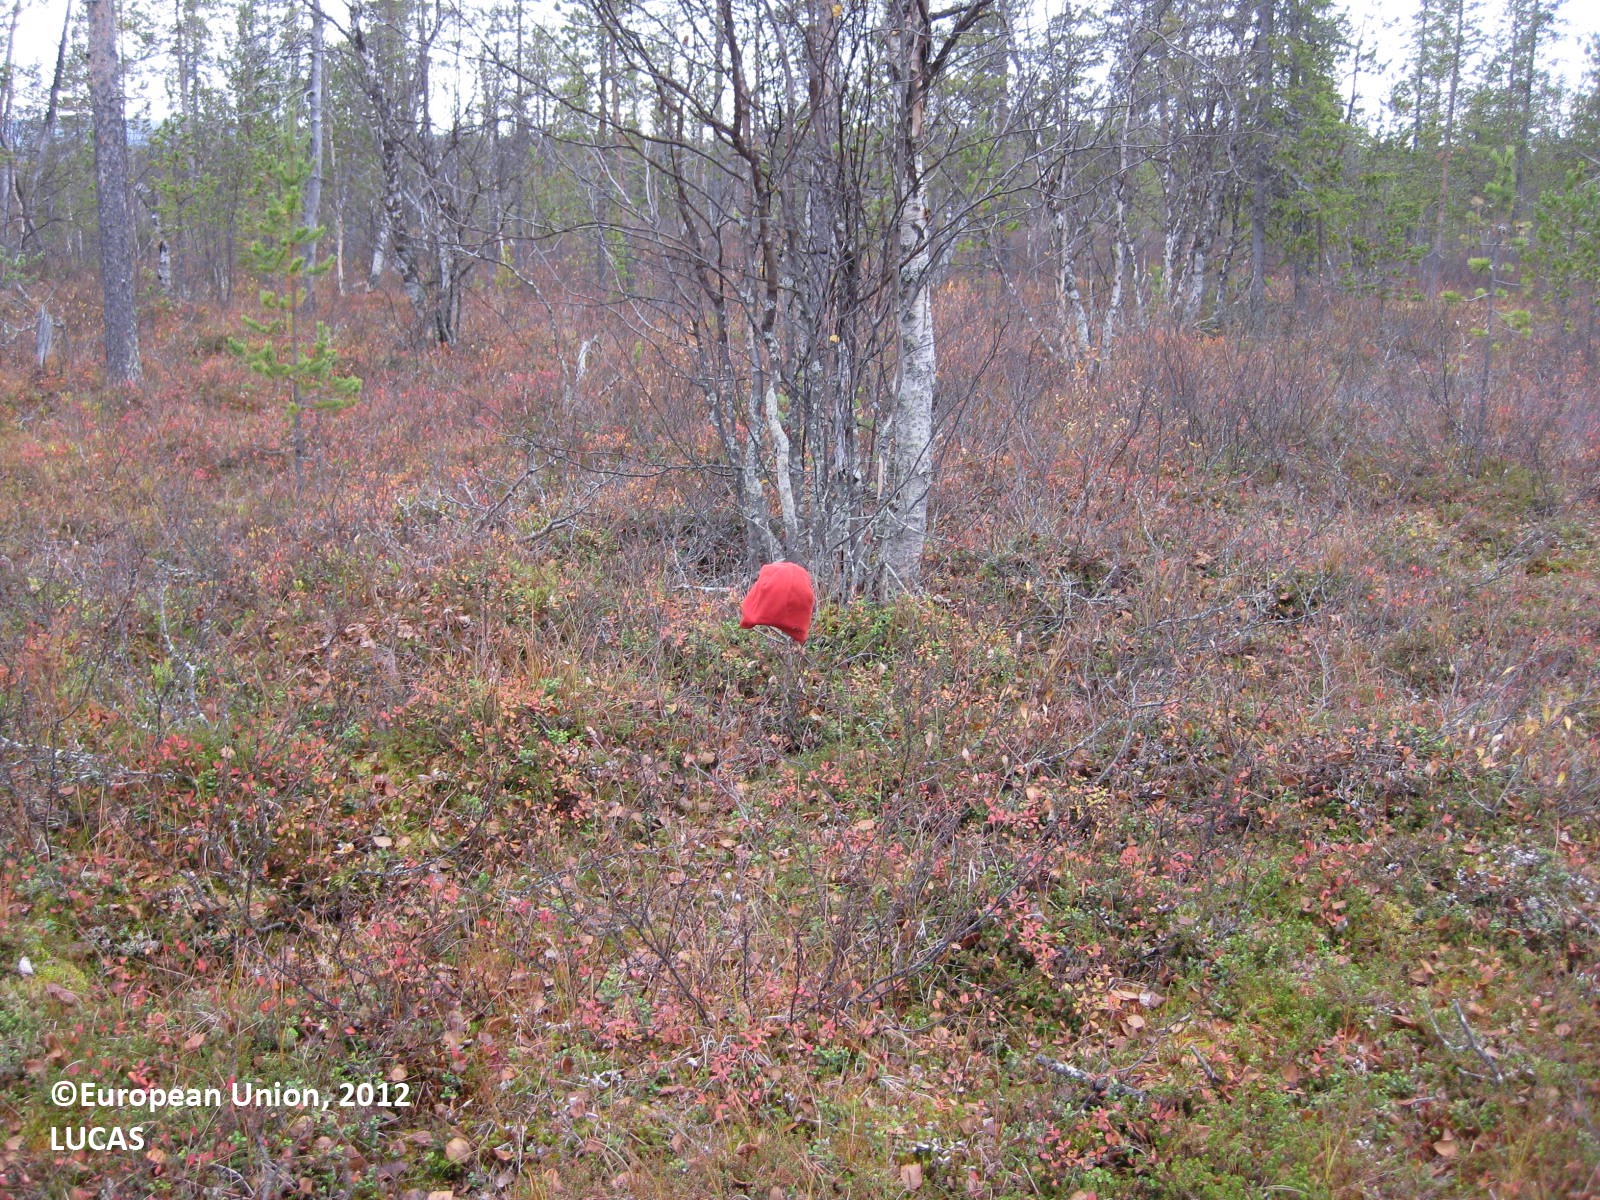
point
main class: Woodland
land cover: Other mixed woodland
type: boreal forest
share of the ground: > 75 %
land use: Forestry
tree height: > 5 m
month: September
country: FI
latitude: 68.0828
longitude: 23.6212
